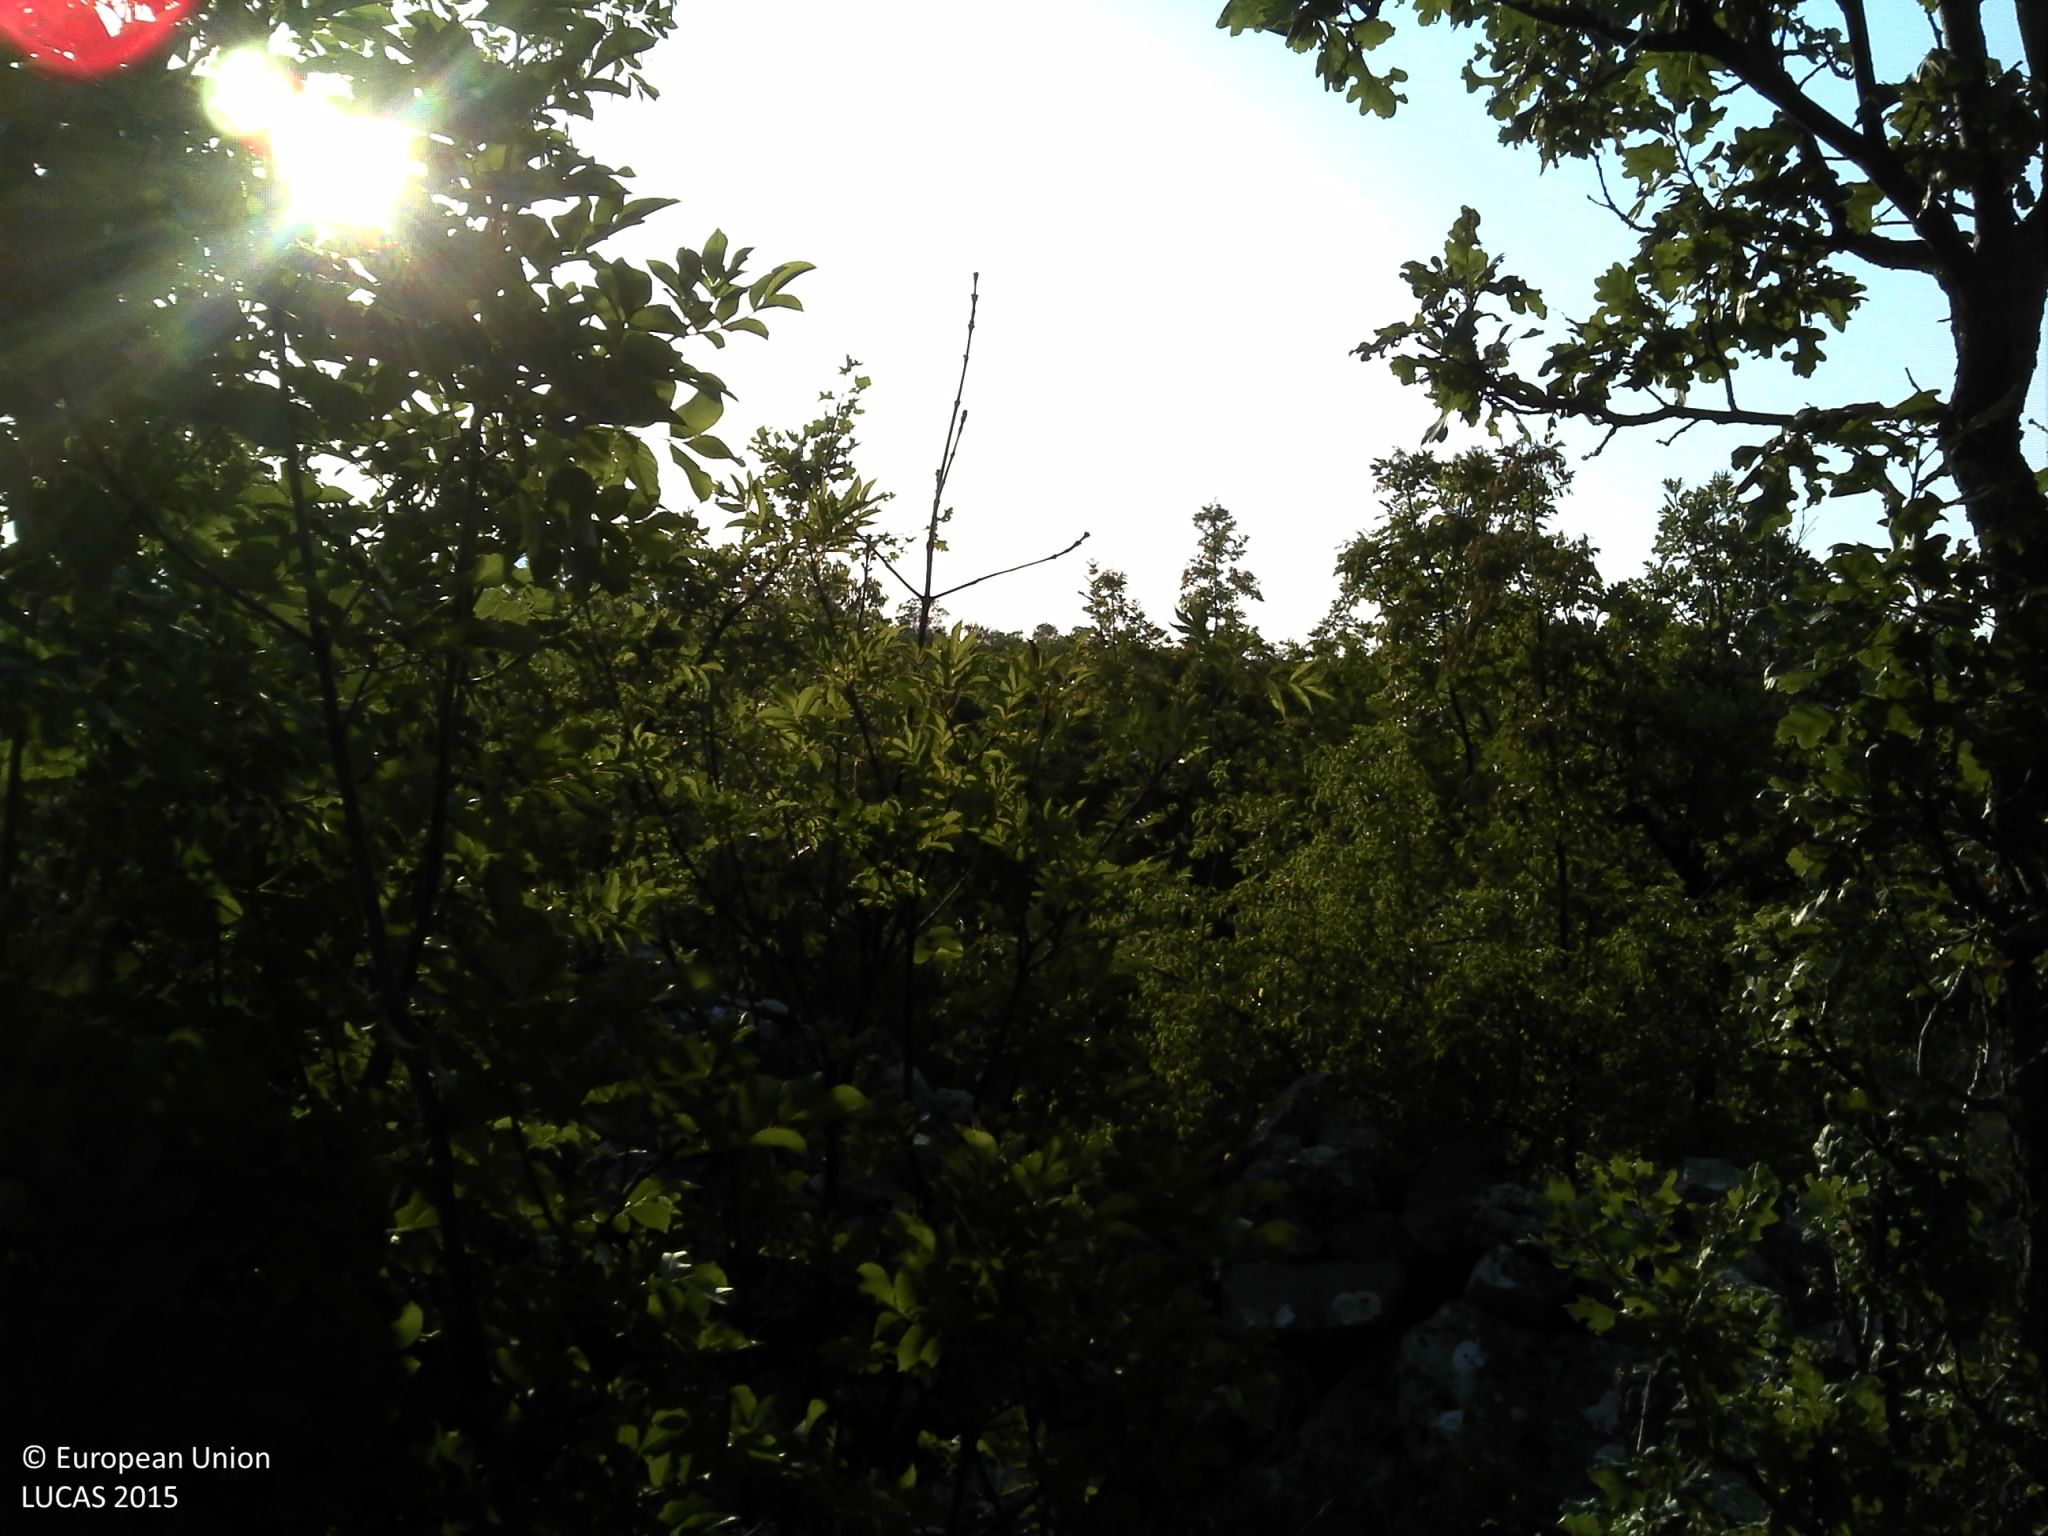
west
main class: Woodland
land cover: Broadleaved woodland
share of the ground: 10 - 25 %
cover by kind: shrubs 30 %, broadleaved forest trees 25 %, unconsolidated bare surface 25 %, herbaceous plants 20 %
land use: Semi-natural and natural areas not in use
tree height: > 5 m
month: July
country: HR
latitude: 43.8891
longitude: 16.2782
